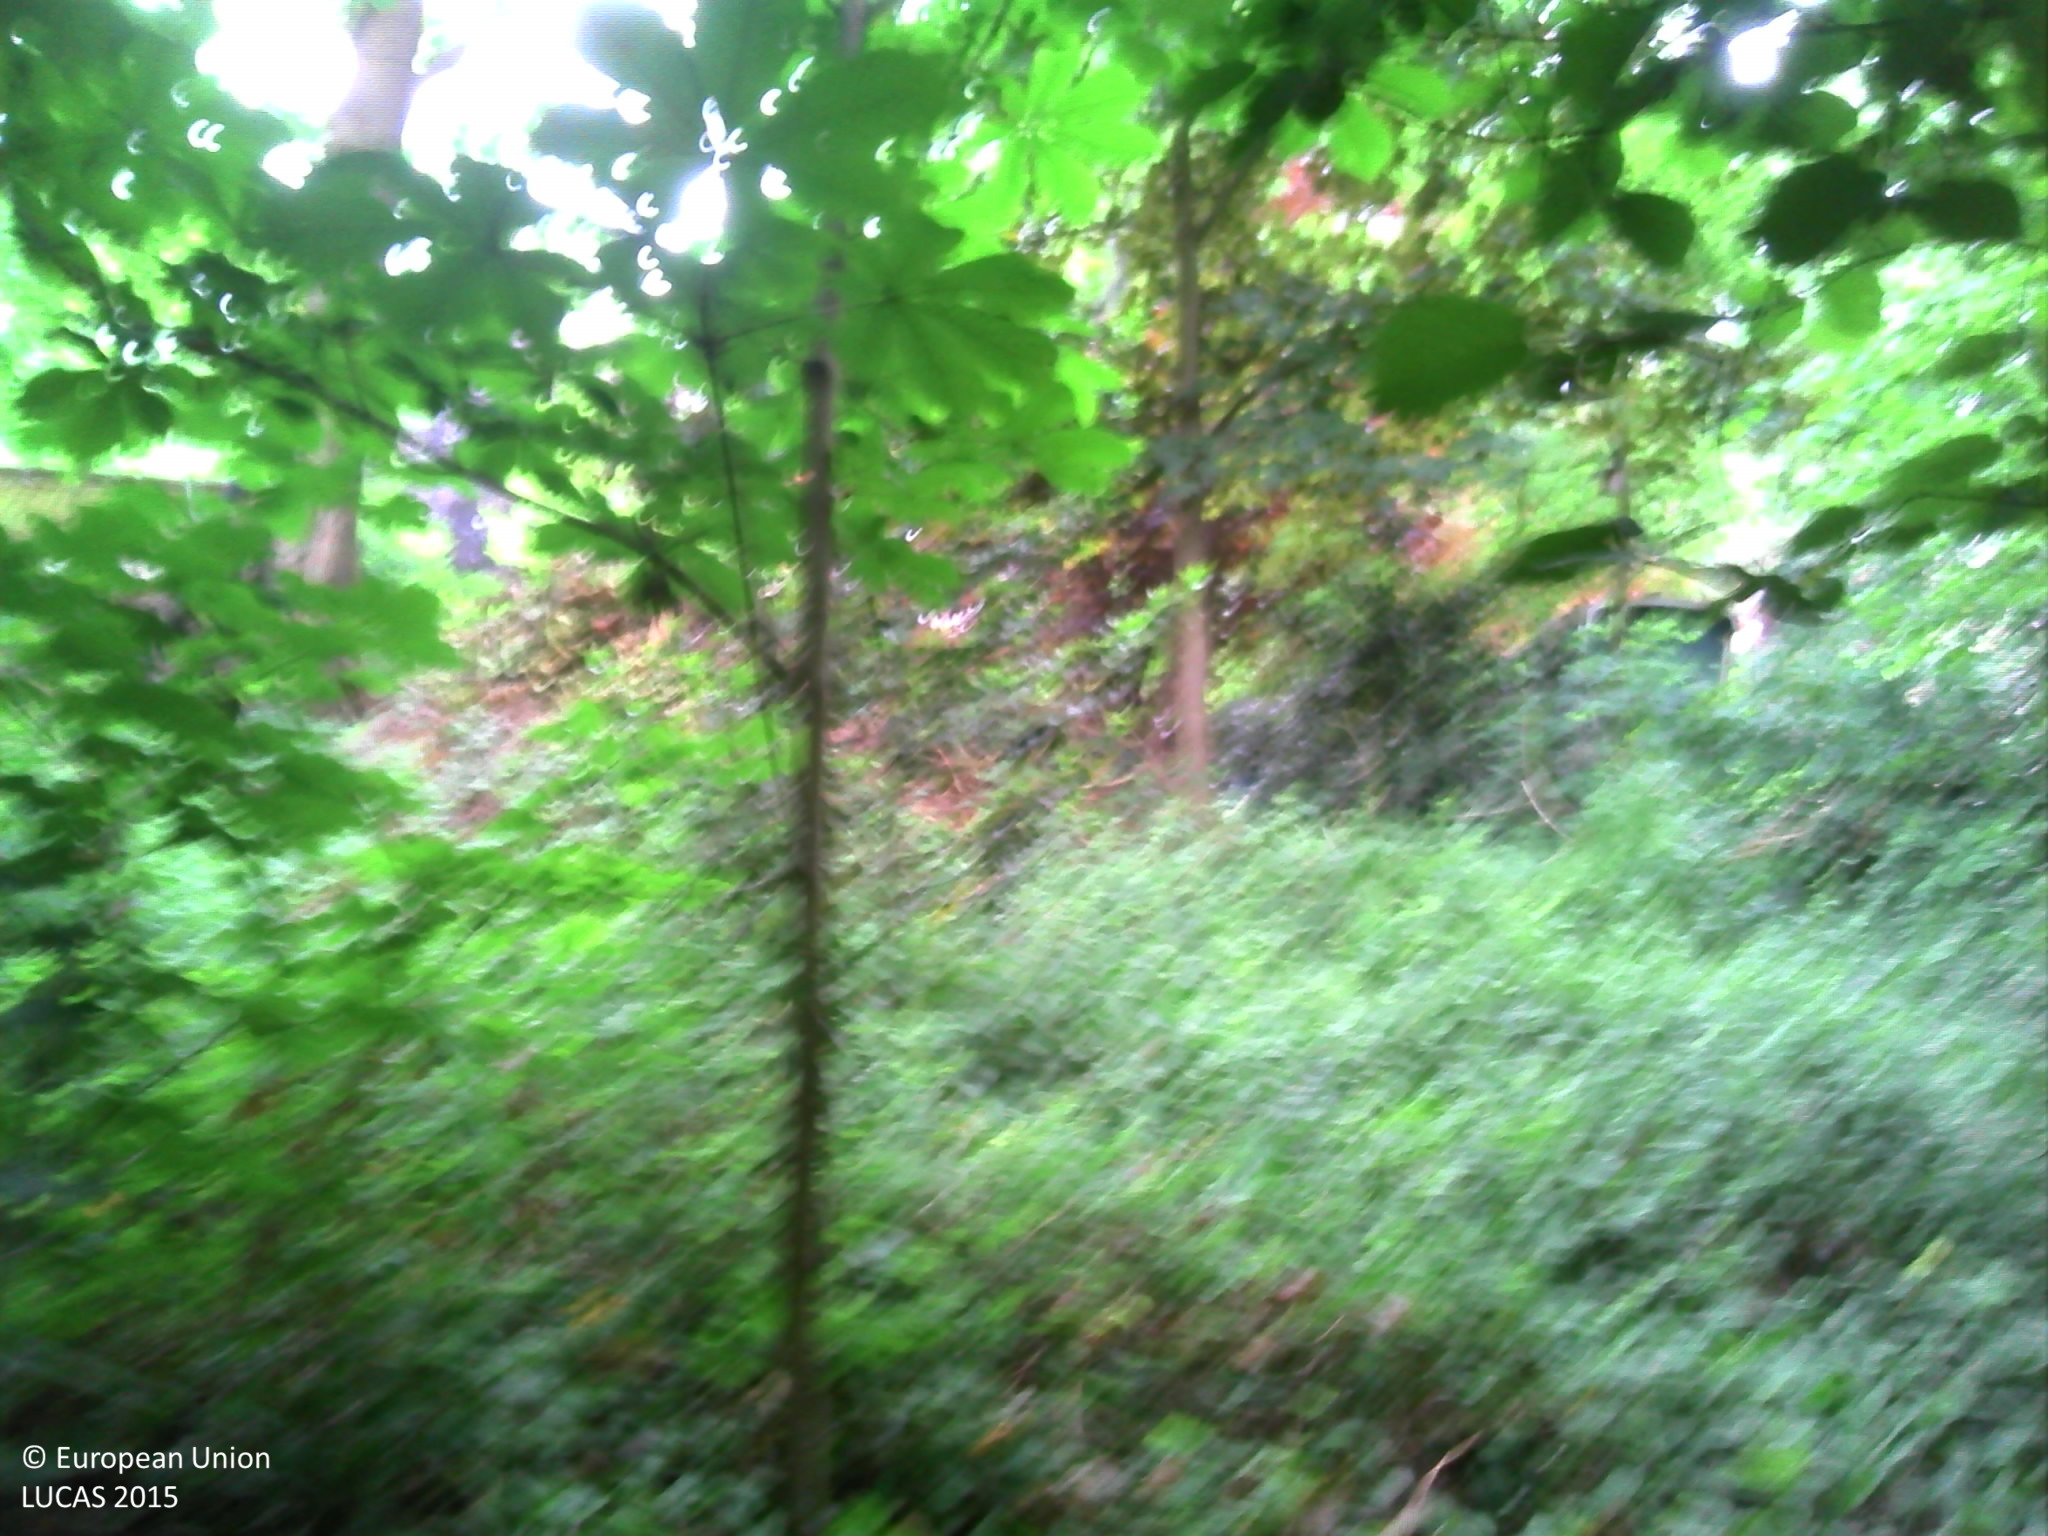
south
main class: Woodland
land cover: Broadleaved woodland
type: mesophytic deciduous forest
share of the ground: > 75 %
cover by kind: broadleaved forest trees 100 %
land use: Forestry
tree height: > 5 m
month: May
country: BE
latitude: 50.7038
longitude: 4.5729
